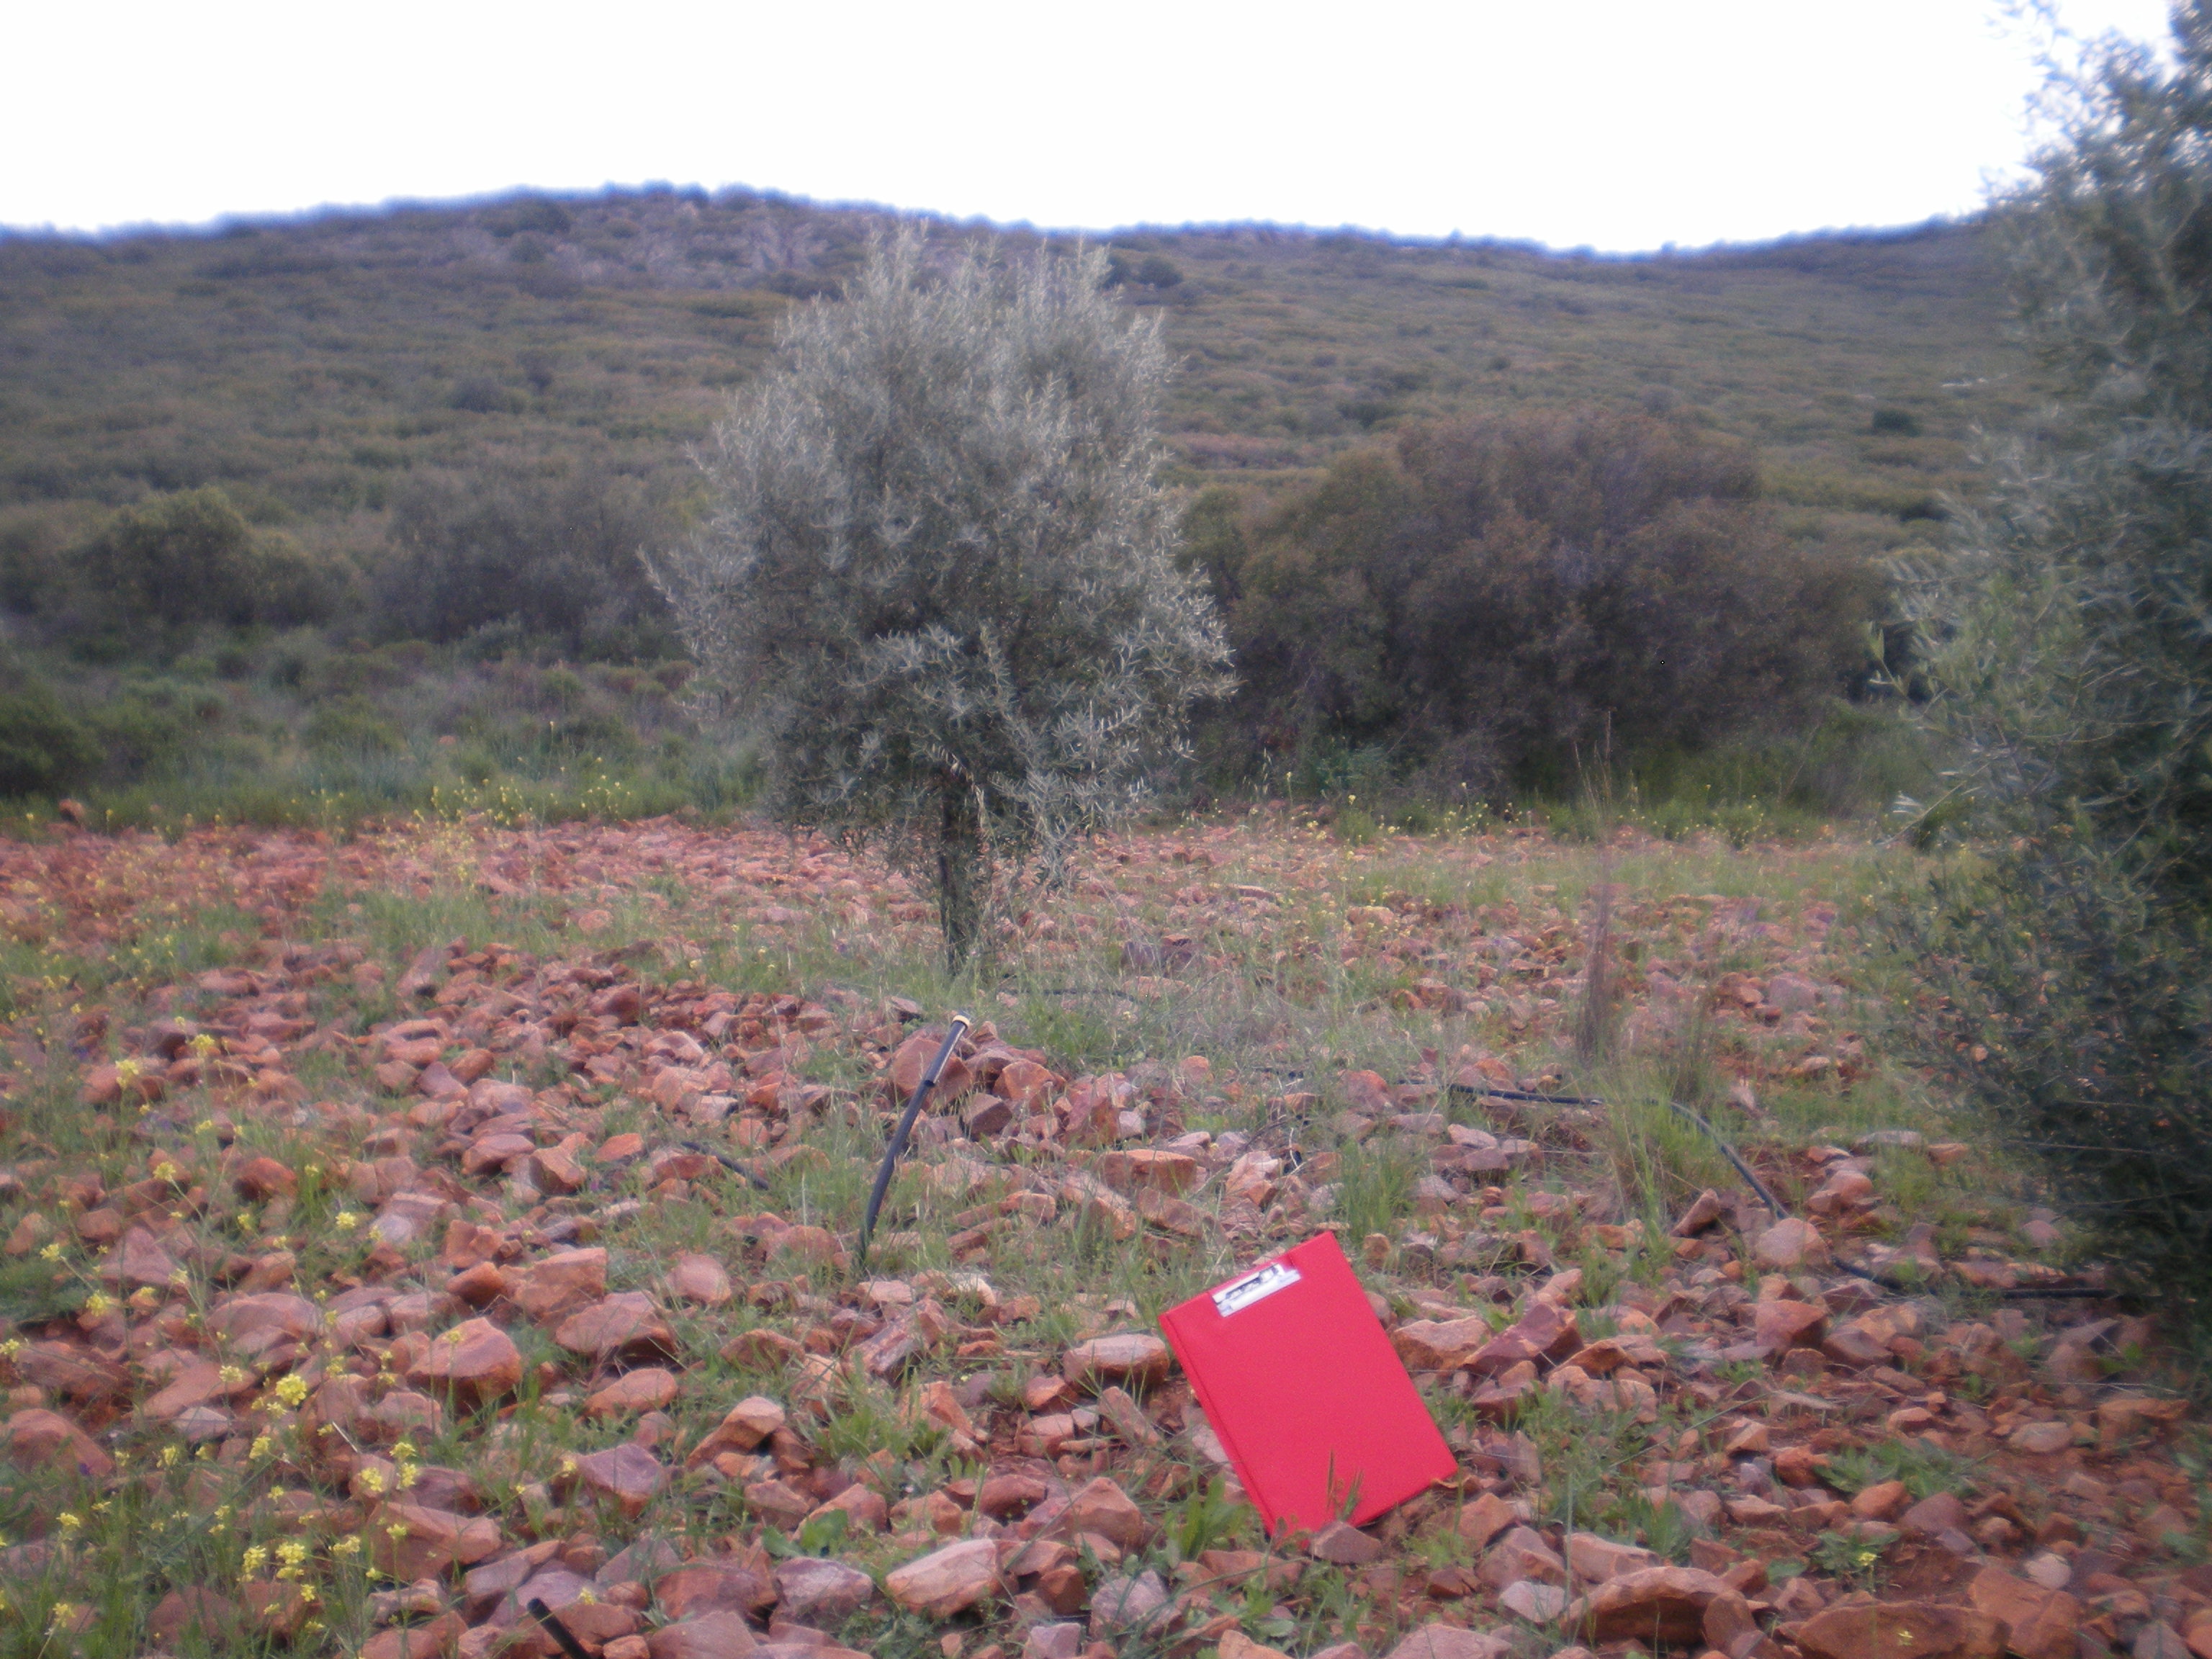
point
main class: Cropland
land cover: Olive groves
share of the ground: 10 - 25 %
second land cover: Spontaneously vegetated surfaces
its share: 25 - 50 %
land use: Agriculture (excluding fallow land and kitchen gardens)
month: April
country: ES
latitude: 38.8636
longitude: -3.5557
